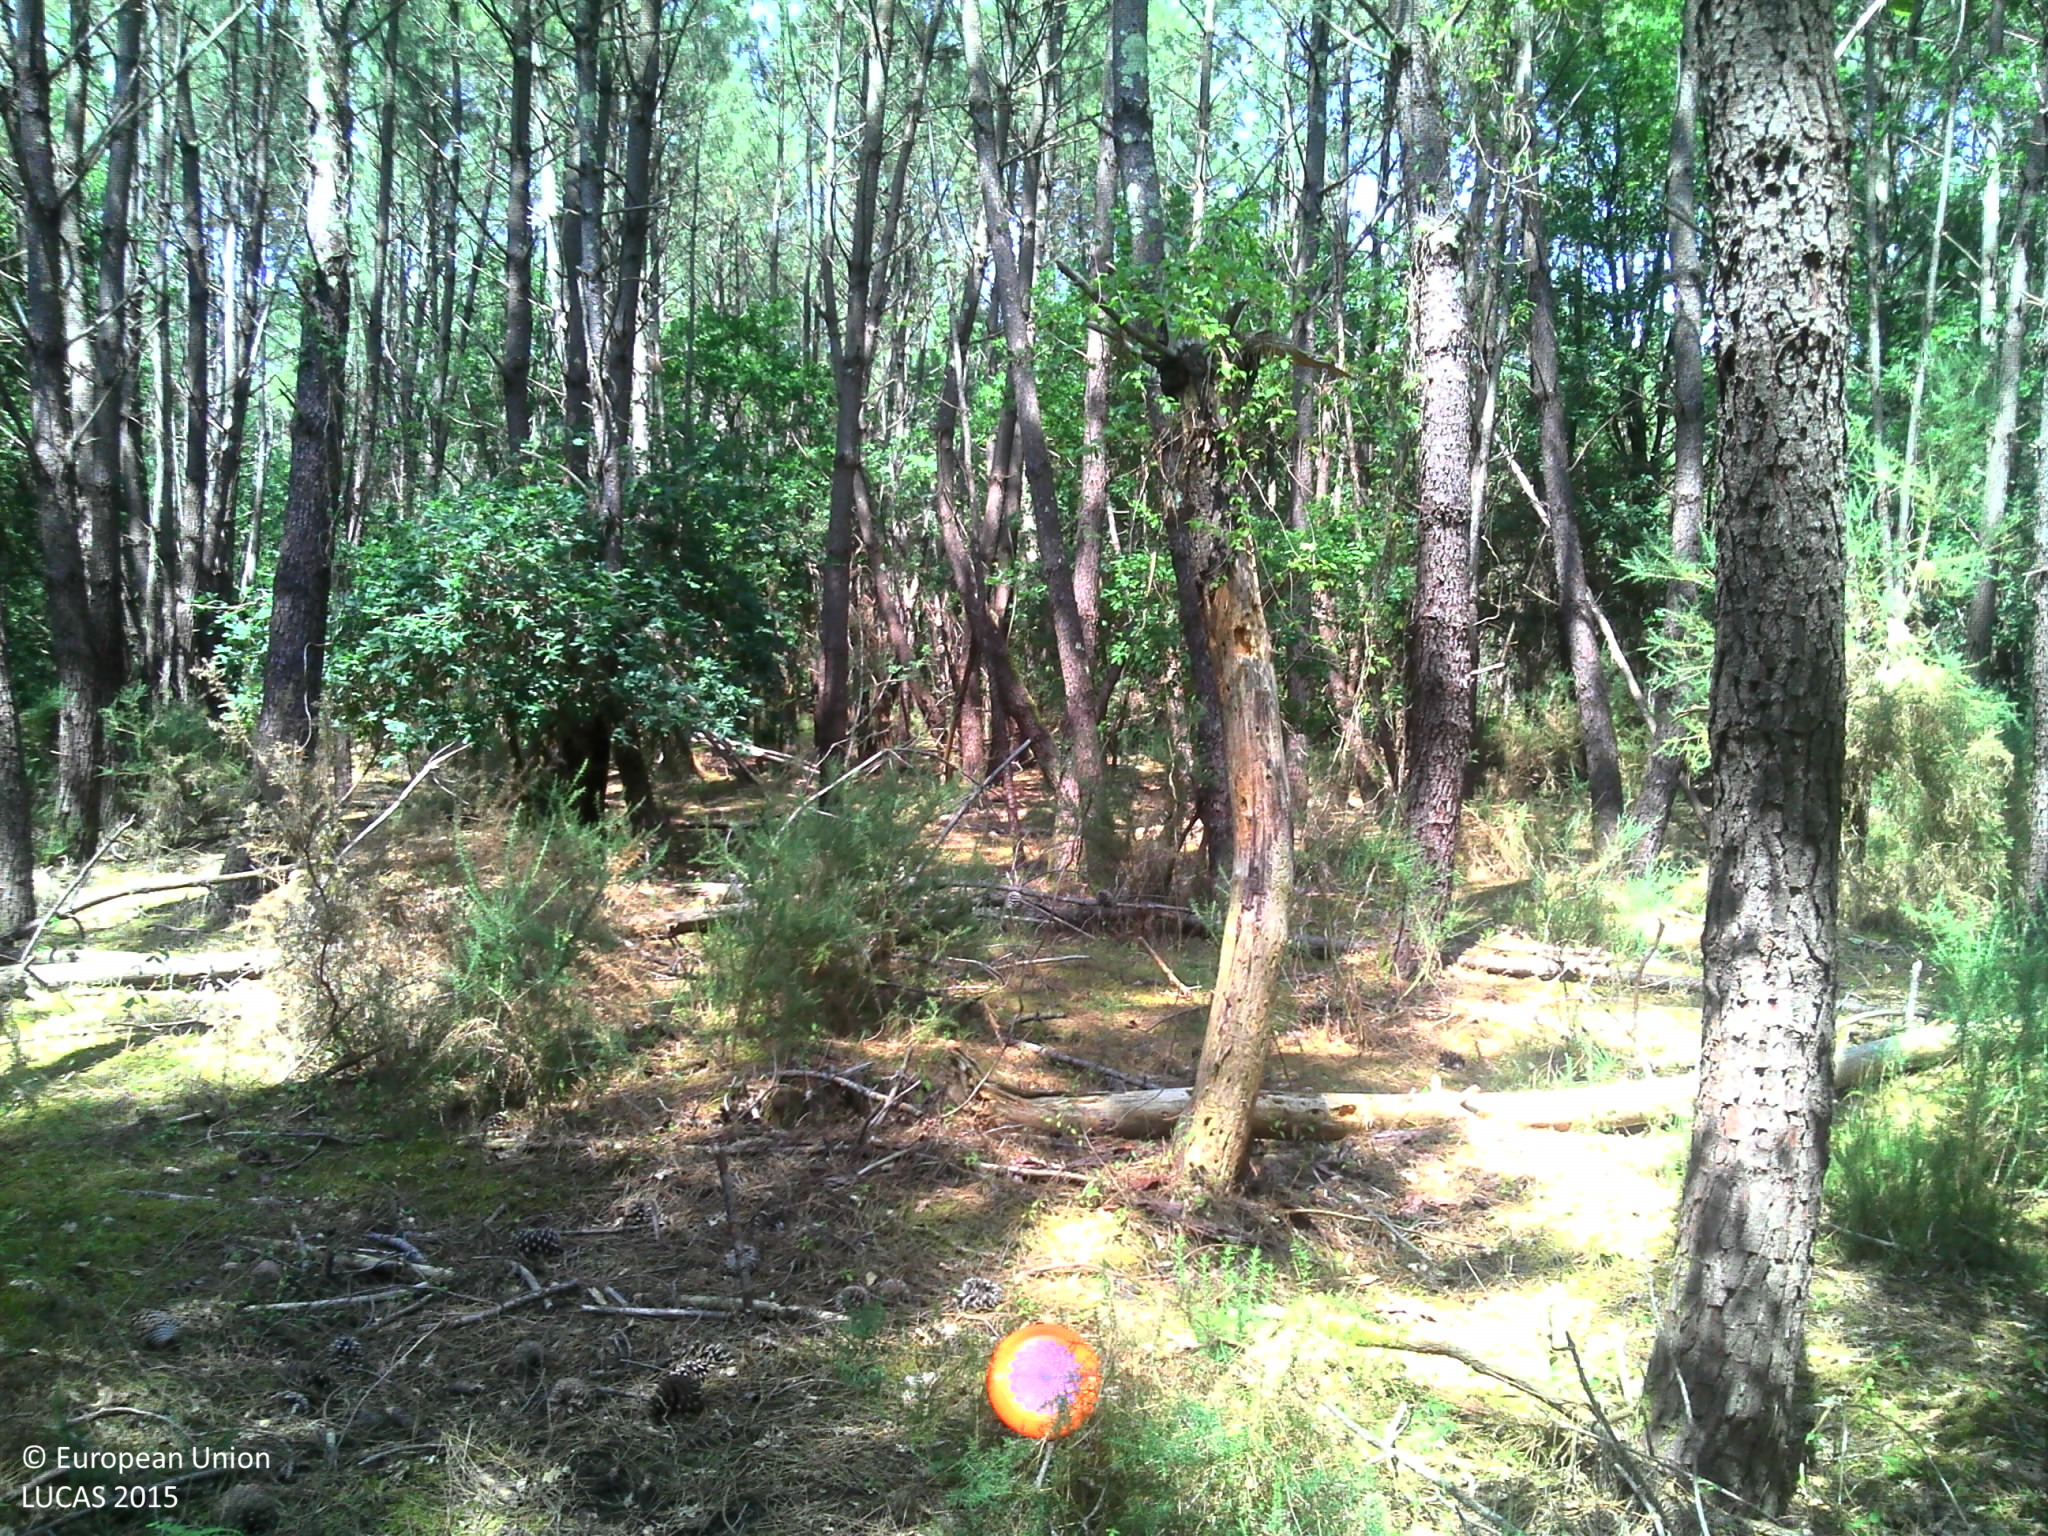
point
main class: Woodland
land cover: Pine dominated mixed woodland
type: coniferous forest of the mediterranean region
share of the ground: > 75 %
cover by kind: coniferous forest trees 50 %, broadleaved forest trees 25 %, lichens and mosses 15 %, herbaceous plants 10 %
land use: Forestry
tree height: > 5 m
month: July
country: FR
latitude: 43.8183
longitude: -1.1700
